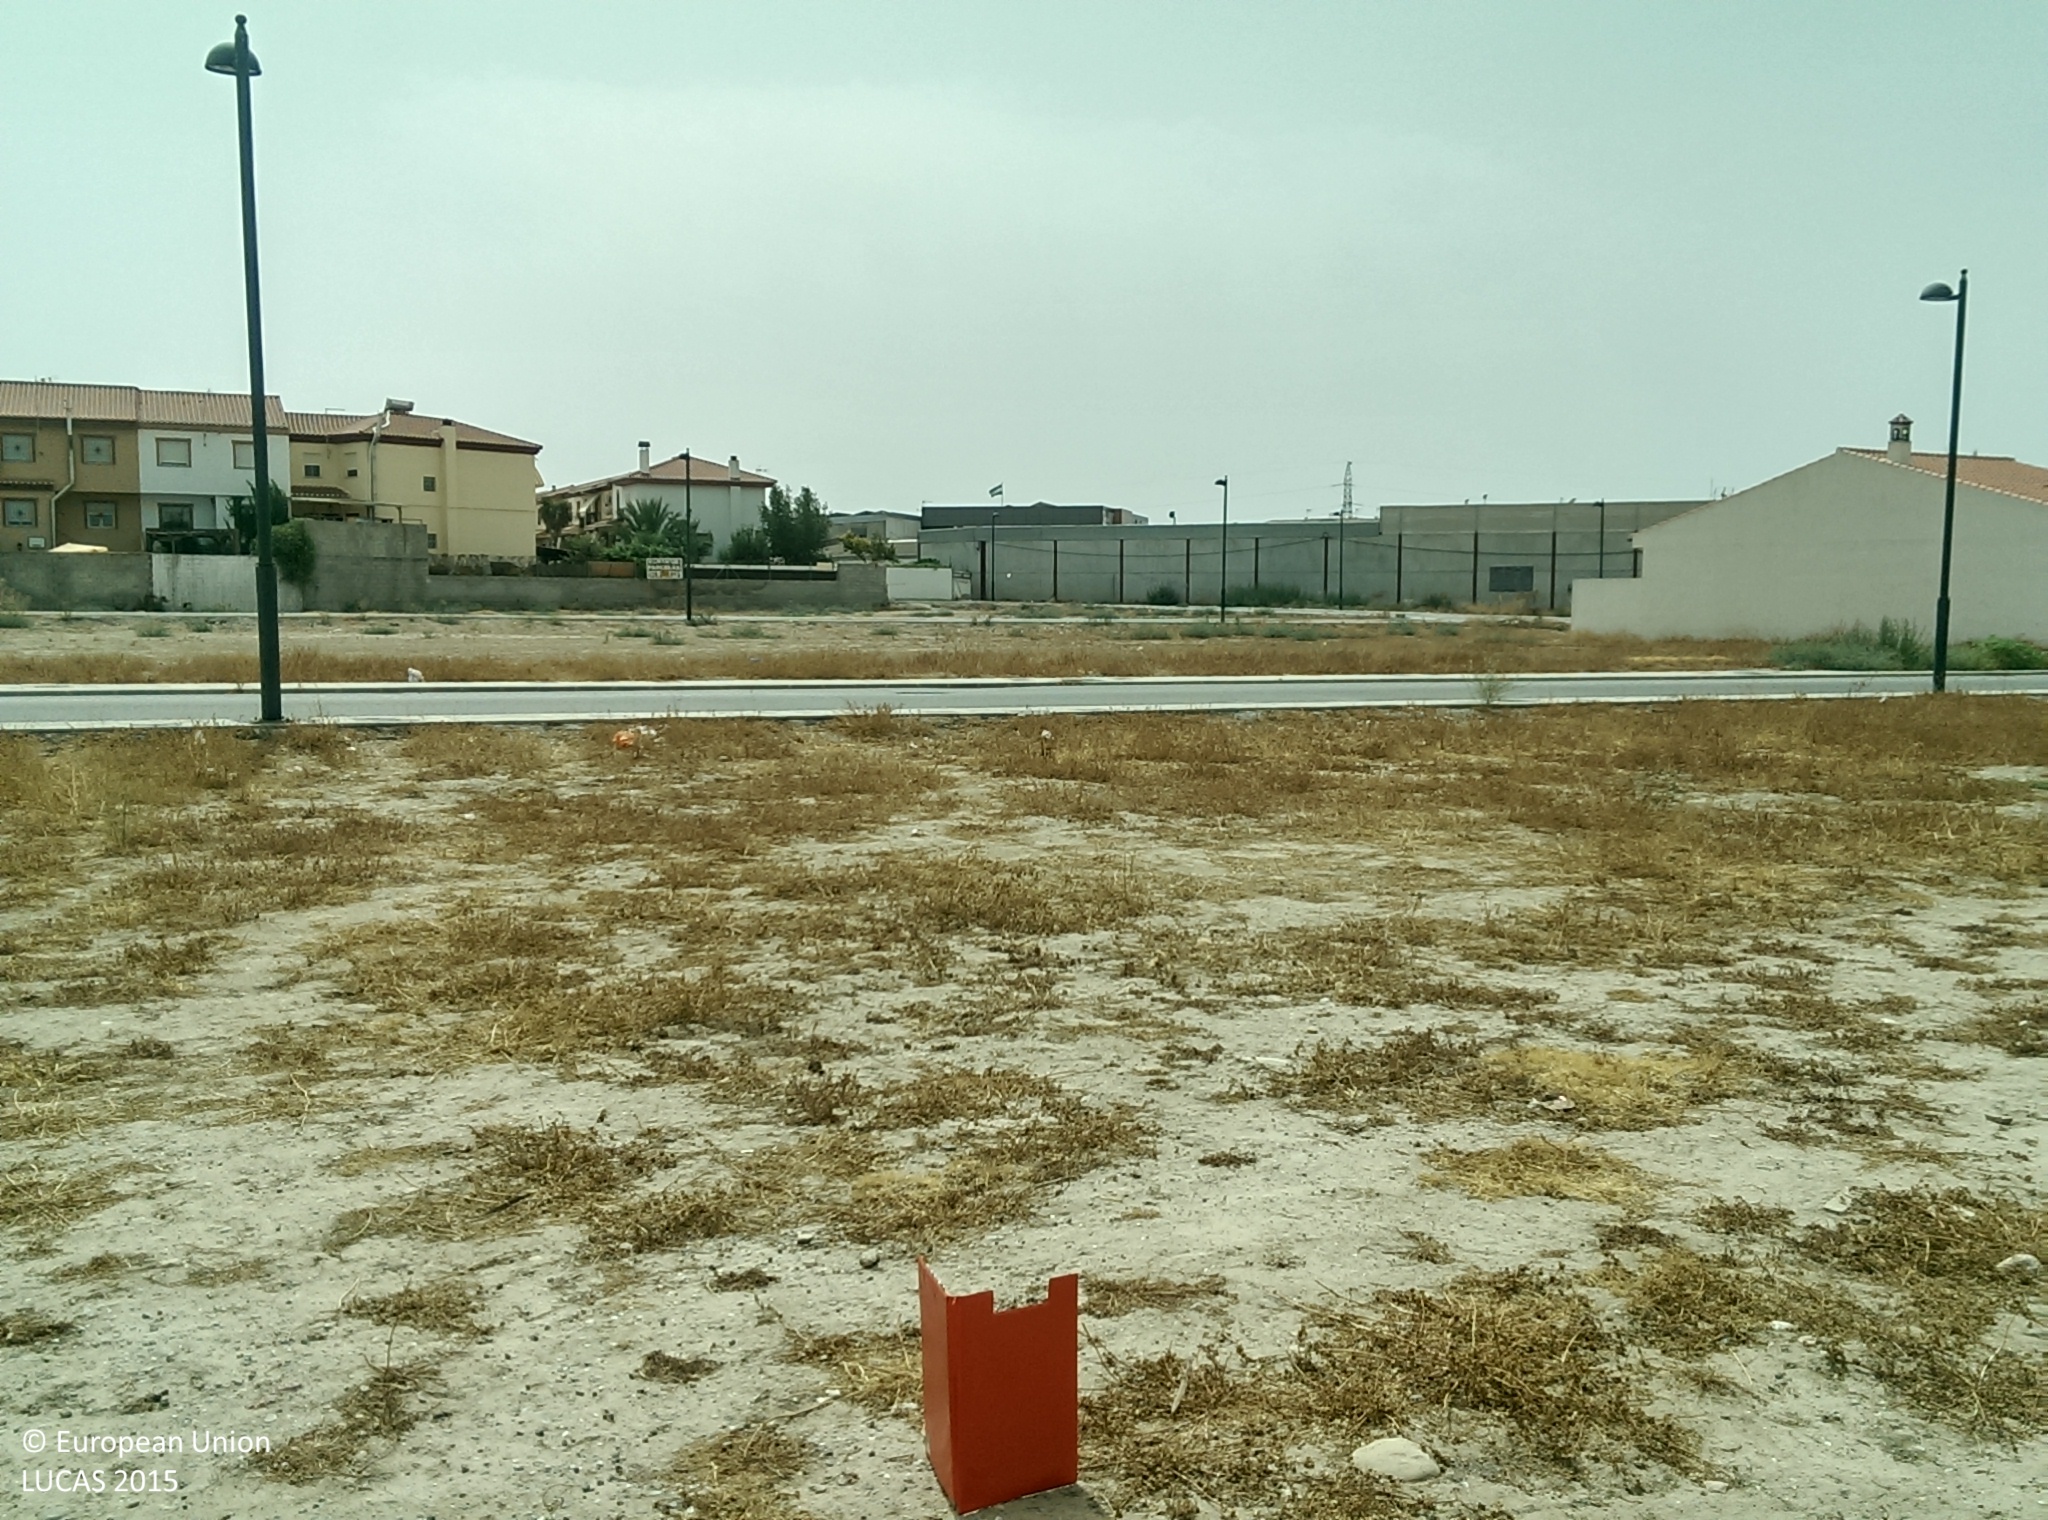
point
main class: Grassland
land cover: Grassland without tree/shrub cover
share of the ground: 10 - 25 %
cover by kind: unconsolidated bare surface 85 %, herbaceous plants 15 %
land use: Residential
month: August
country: ES
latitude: 37.1592
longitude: -3.6712
